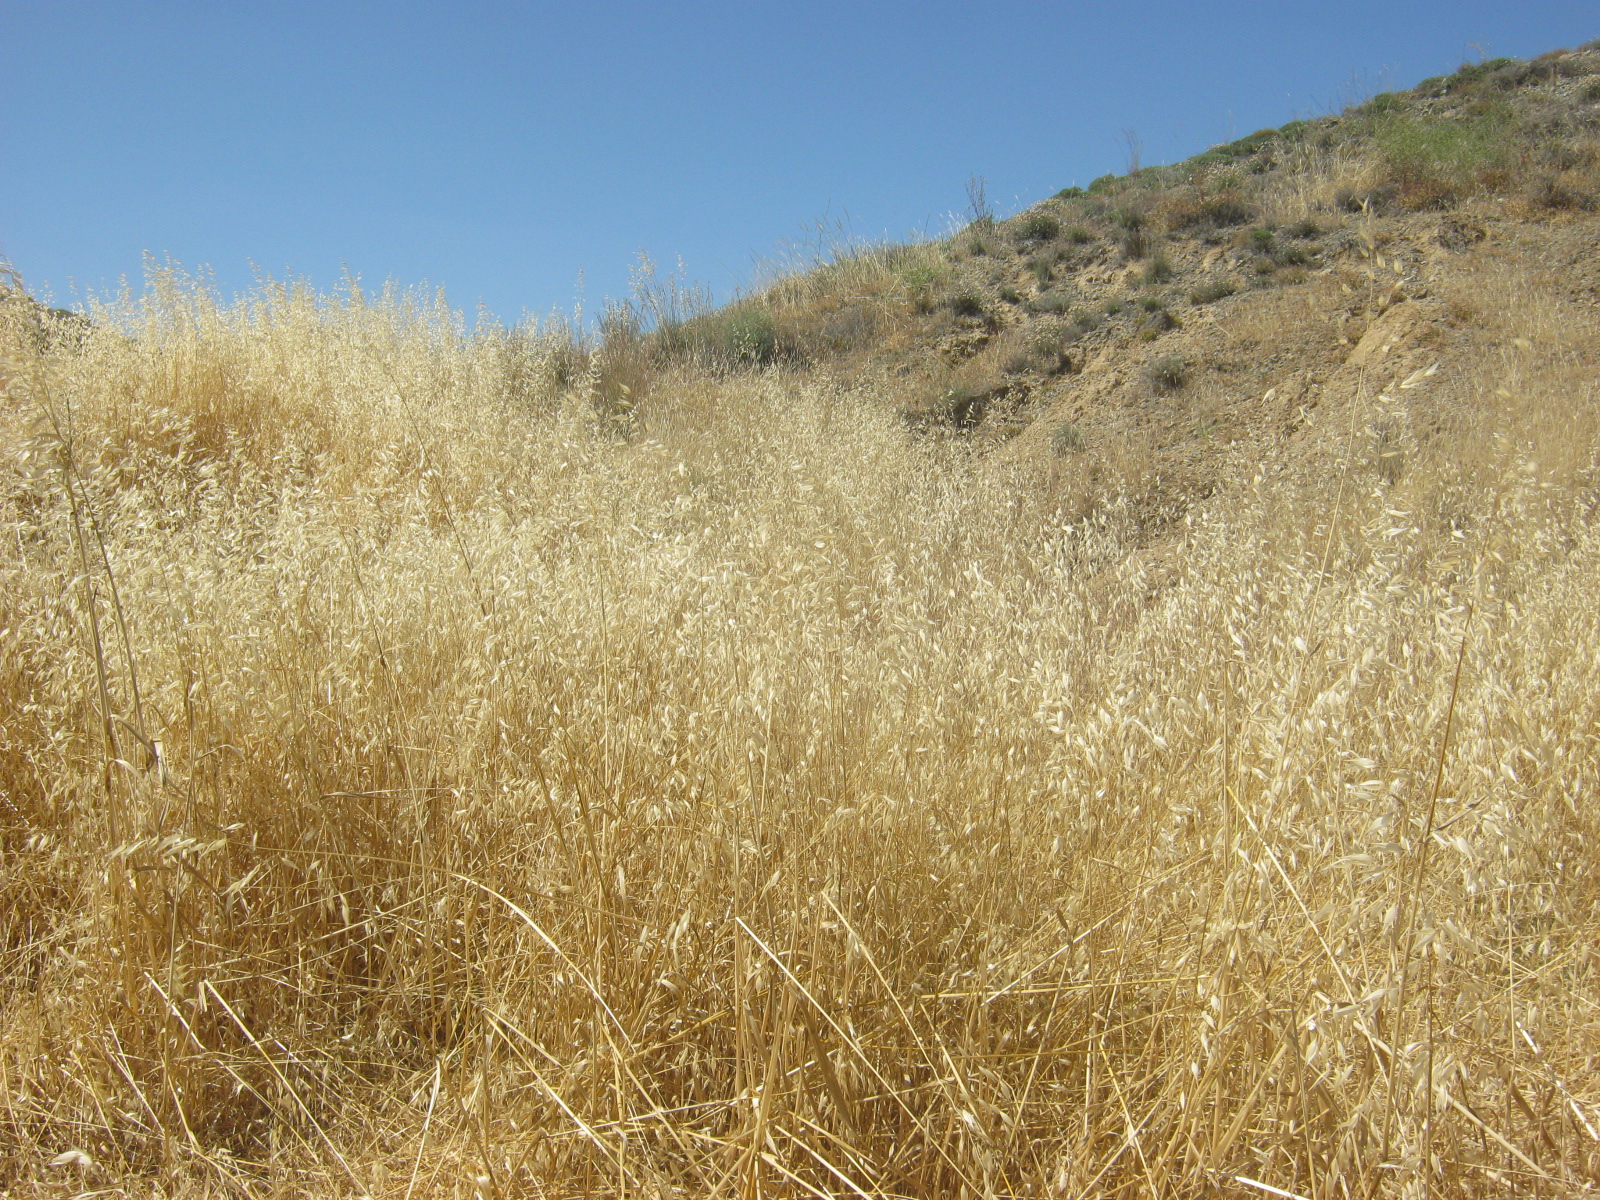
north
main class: Grassland
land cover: Spontaneously vegetated surfaces
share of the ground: > 75 %
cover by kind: herbaceous plants 100 %
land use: Semi-natural and natural areas not in use
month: May
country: CY
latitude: 35.0963
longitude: 33.2107
